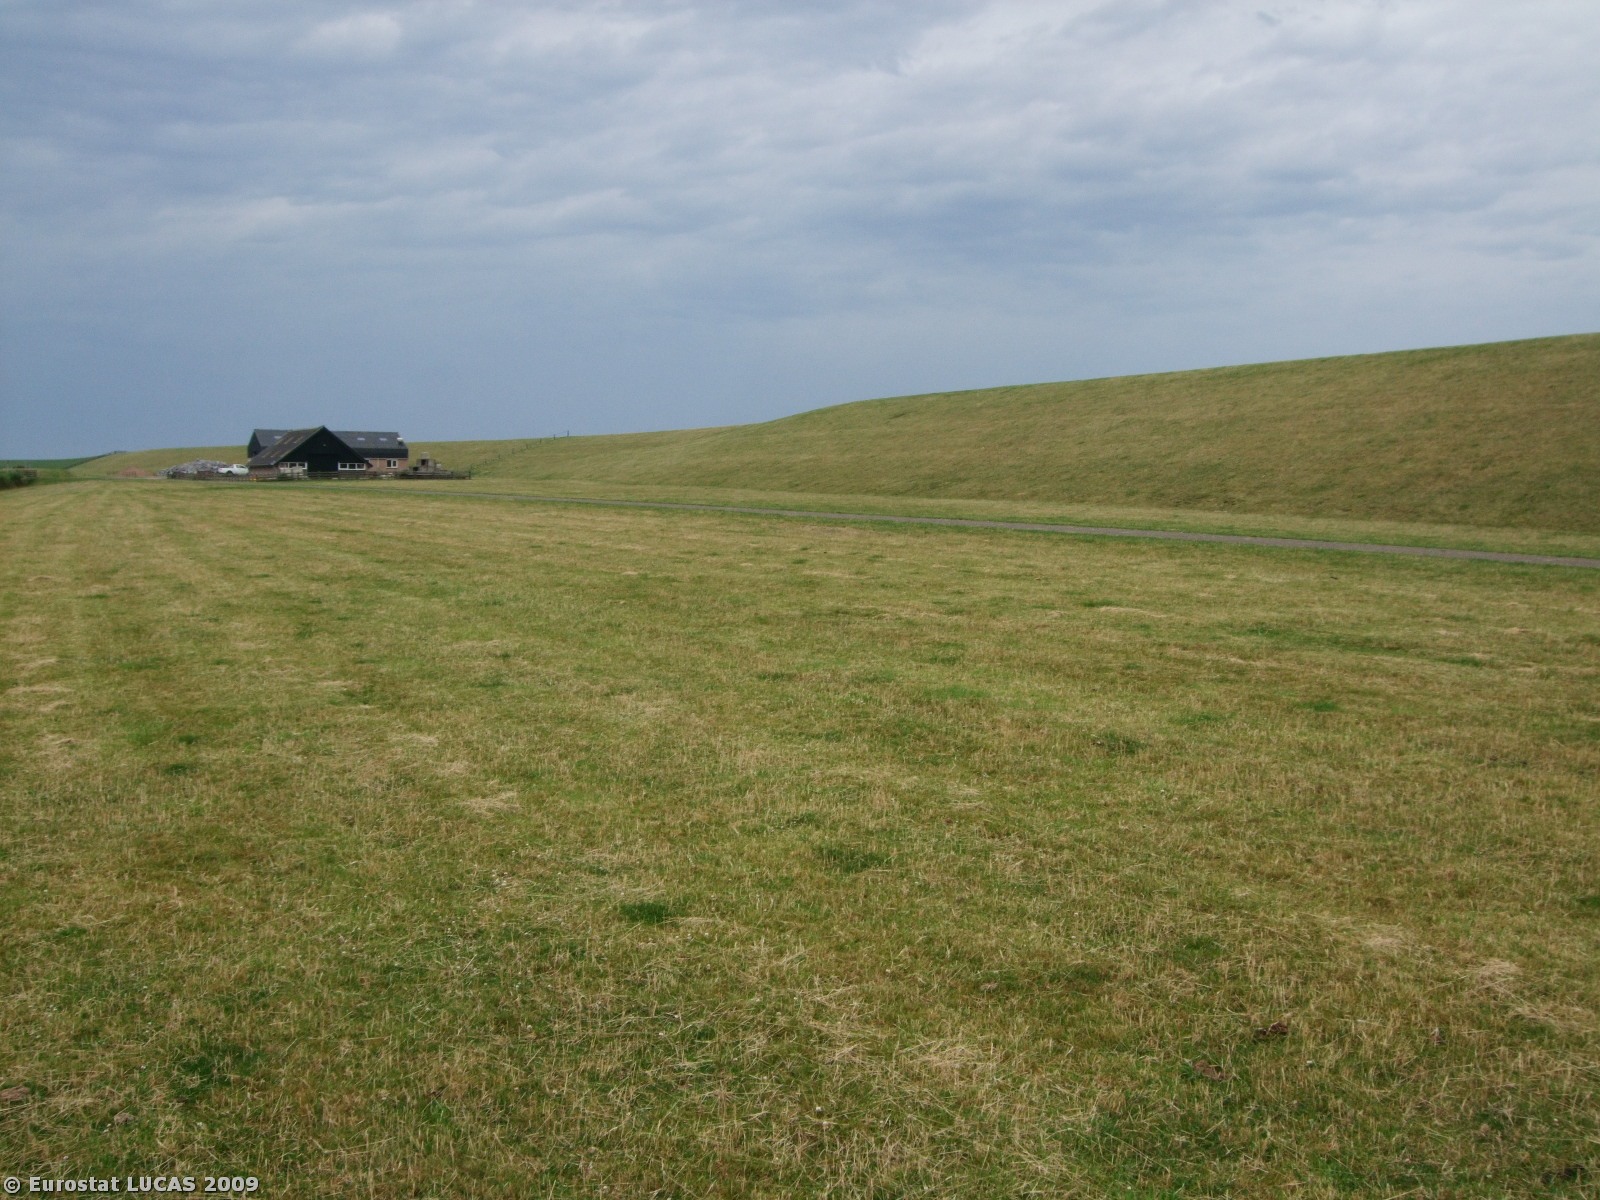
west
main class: Grassland
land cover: Grassland without tree/shrub cover
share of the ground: > 75 %
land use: Protection infrastructures
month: July
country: NL
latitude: 53.3041
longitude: 5.6021
